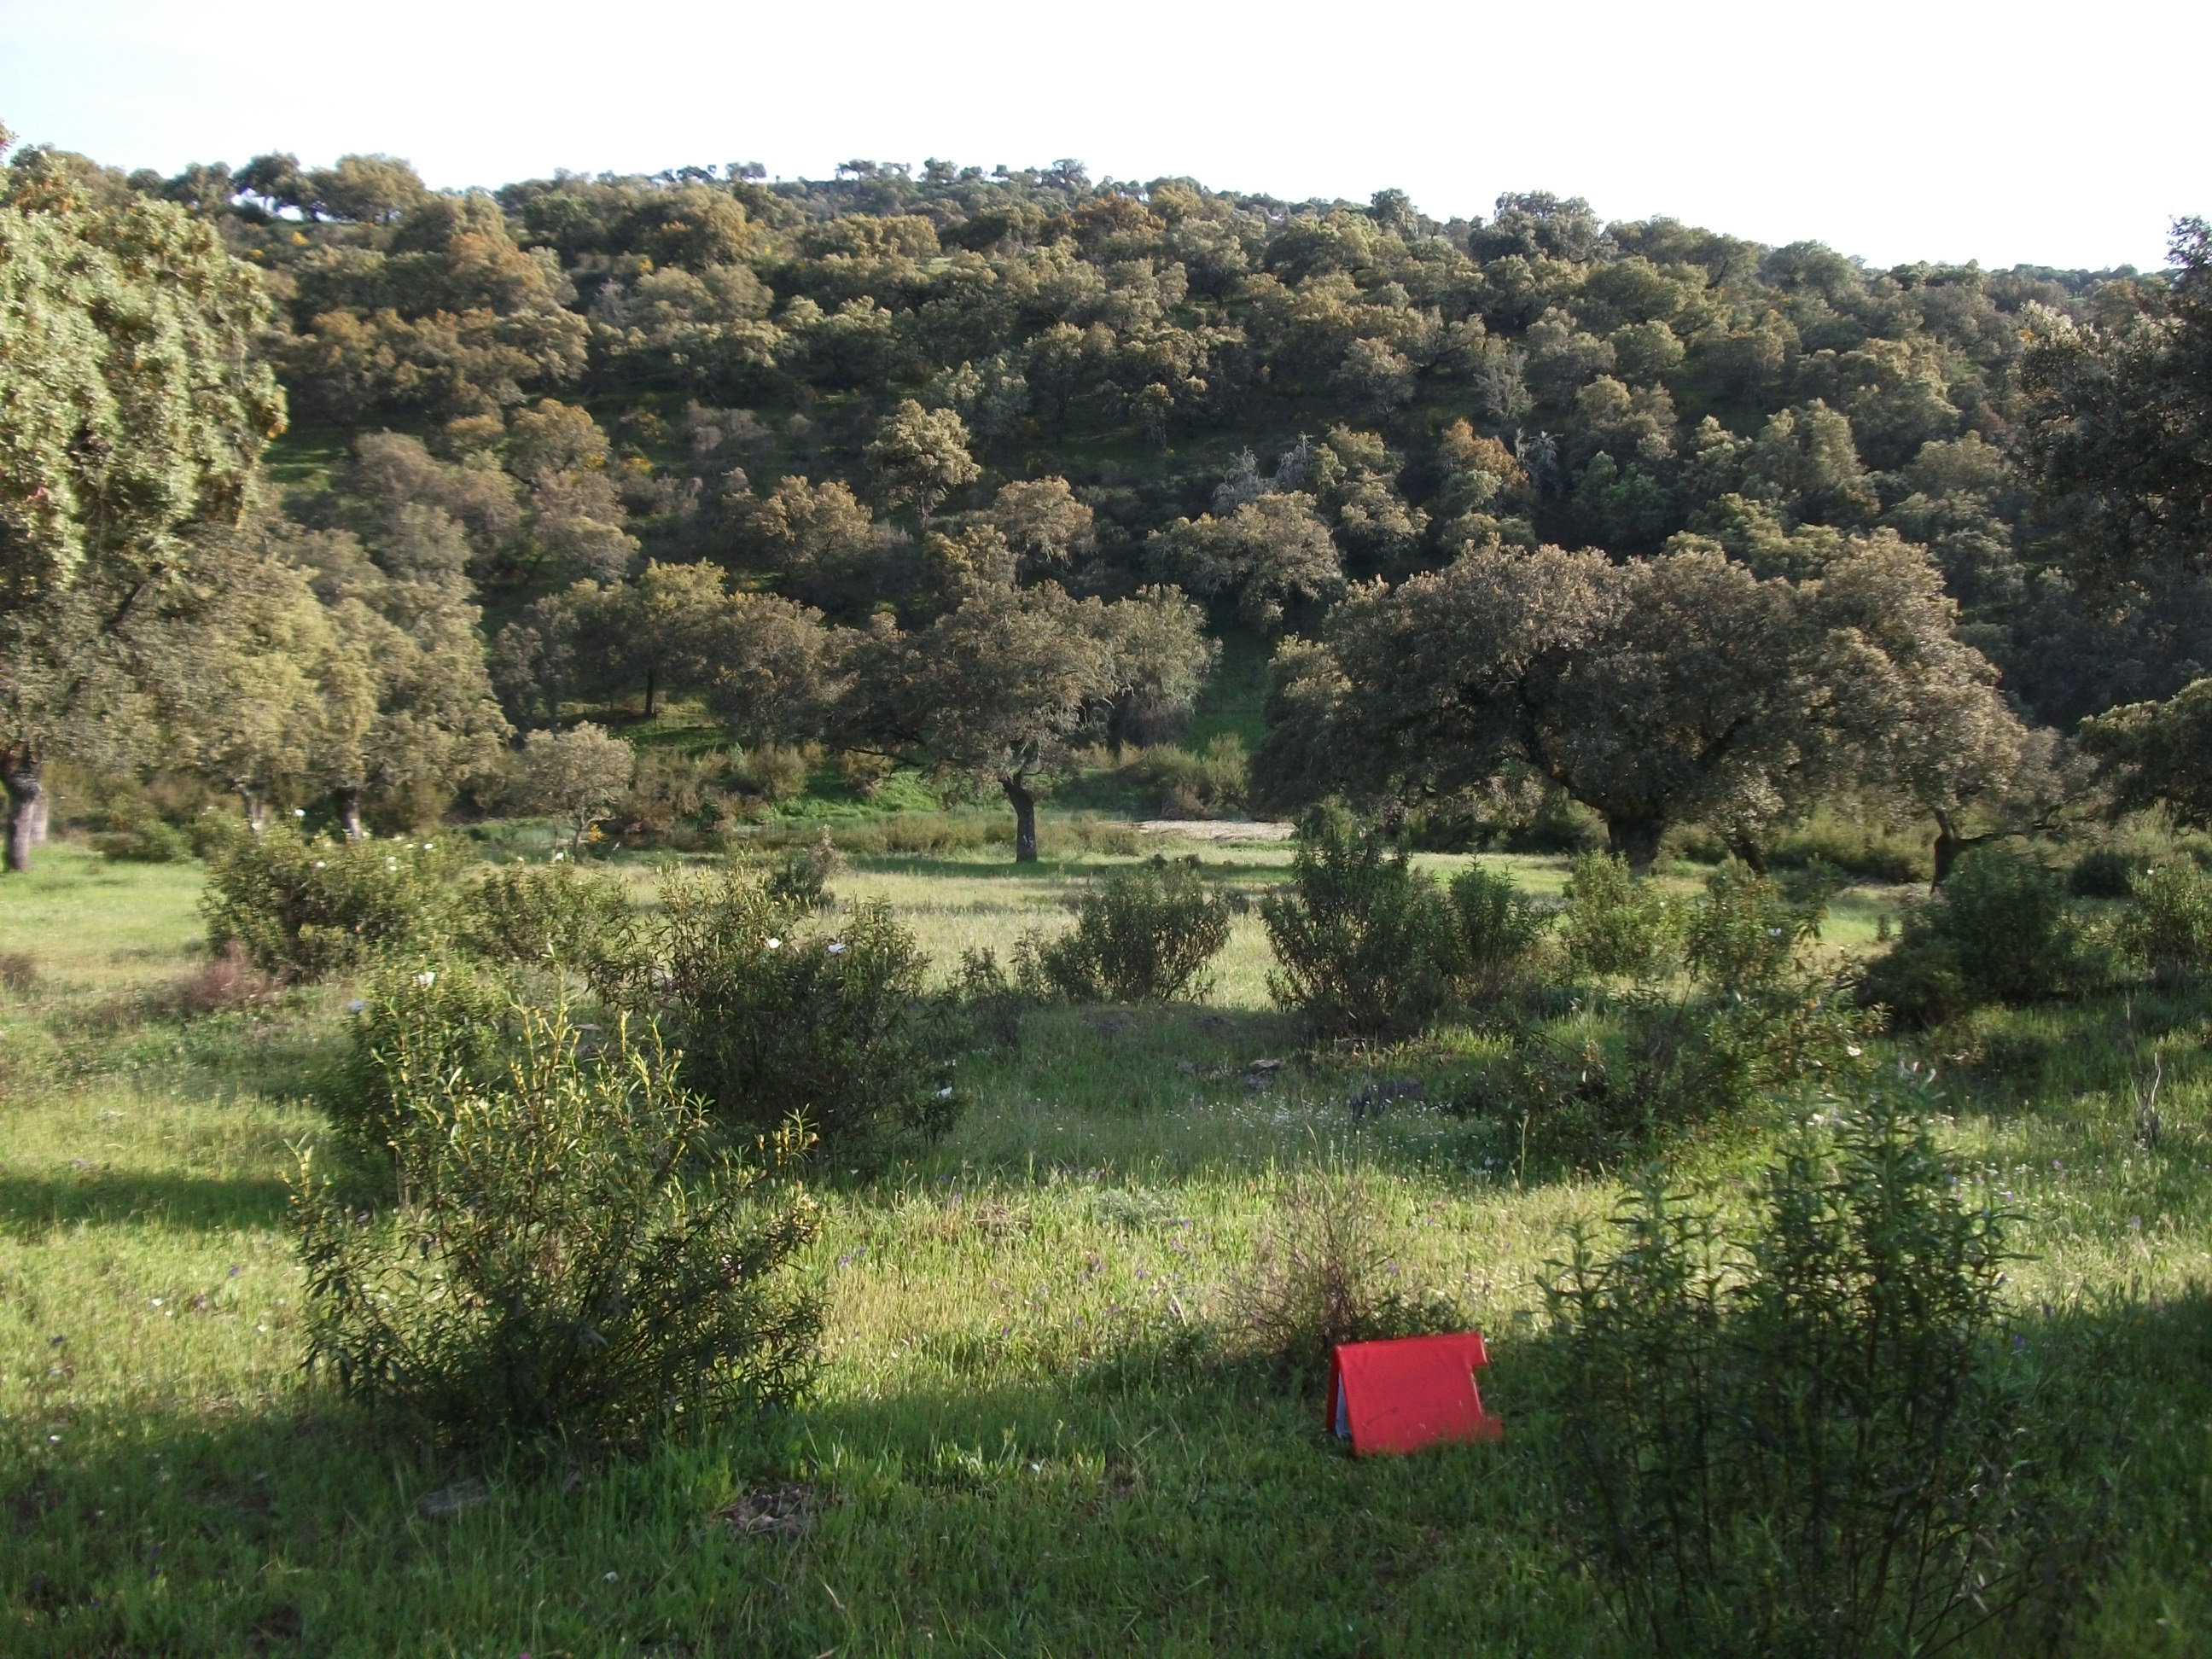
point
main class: Woodland
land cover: Broadleaved woodland
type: broadleaved evergreen forest
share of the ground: 25 - 50 %
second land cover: Spontaneously vegetated surfaces
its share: 50 - 75 %
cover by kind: herbaceous plants 50 %, broadleaved forest trees 40 %, shrubs 10 %
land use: Forestry
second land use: Agriculture (excluding fallow land and kitchen gardens)
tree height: > 5 m
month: April
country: ES
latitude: 38.0936
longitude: -6.6625
